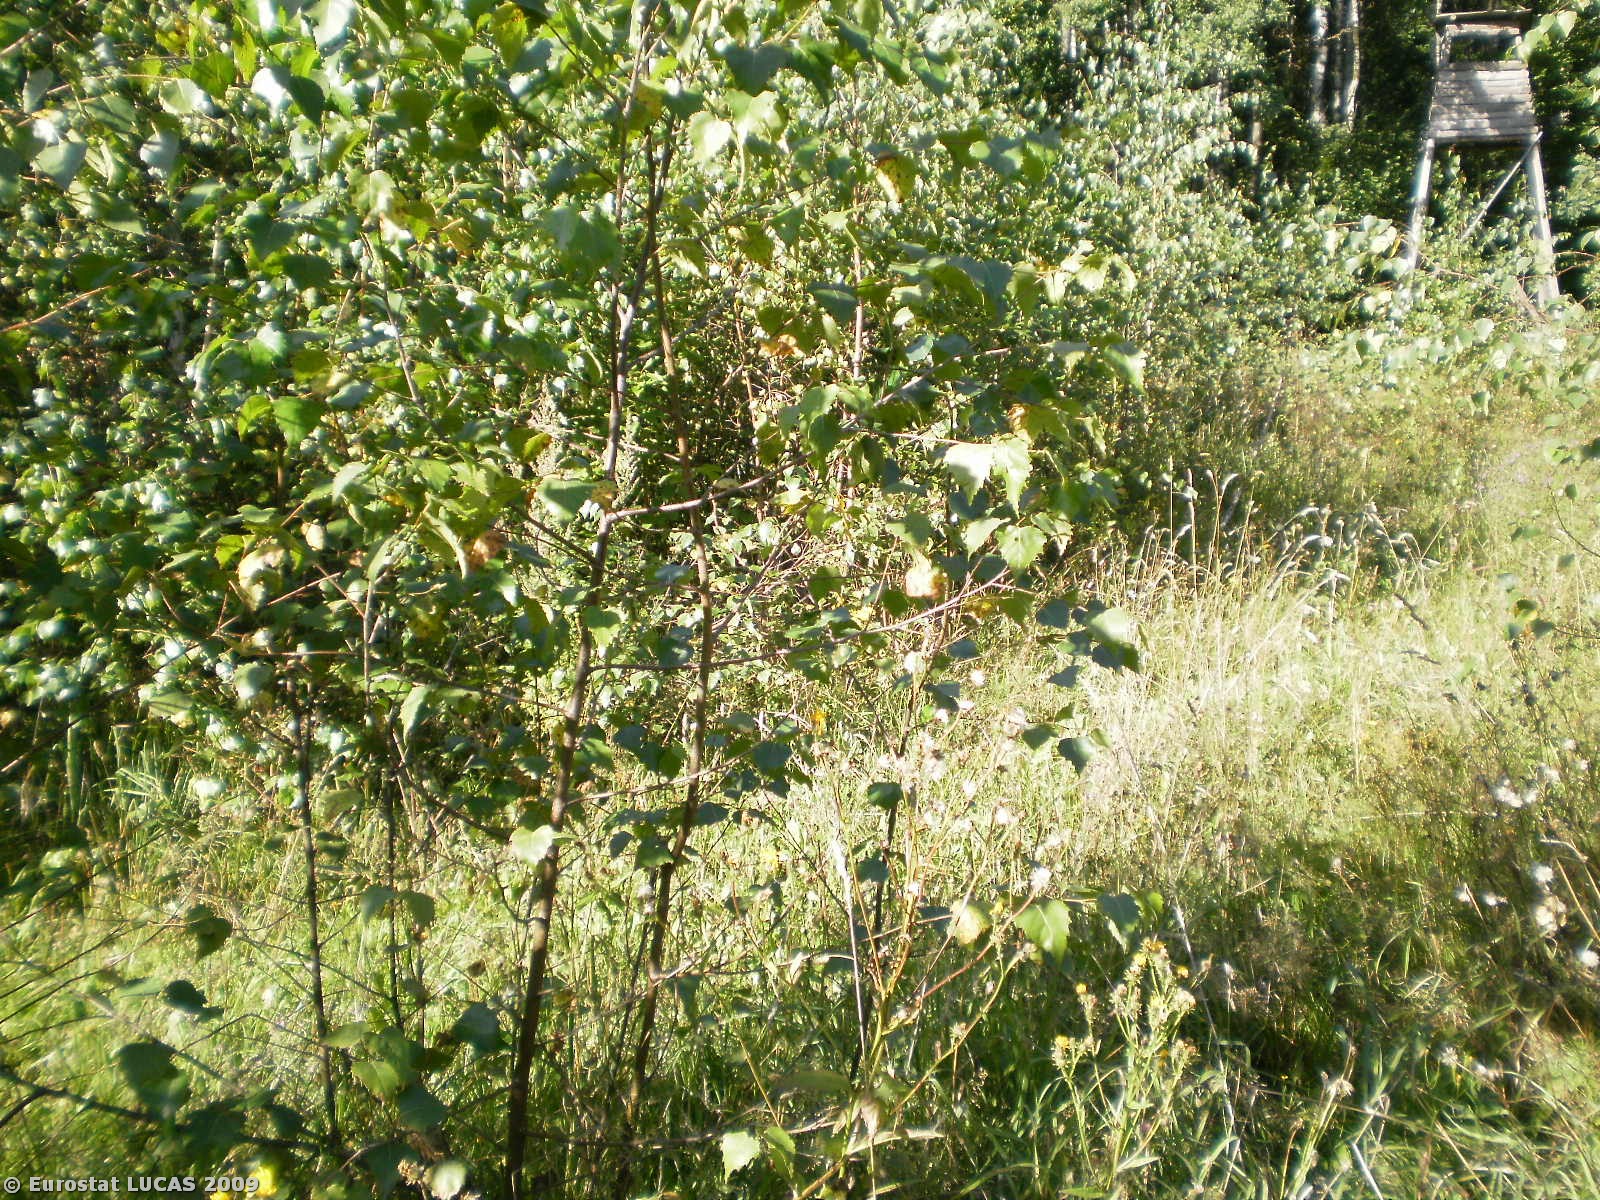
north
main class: Grassland
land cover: Grassland with sparse tree/shrub cover
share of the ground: > 75 %
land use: Unused
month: August
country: PL
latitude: 54.0802
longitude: 21.1878
